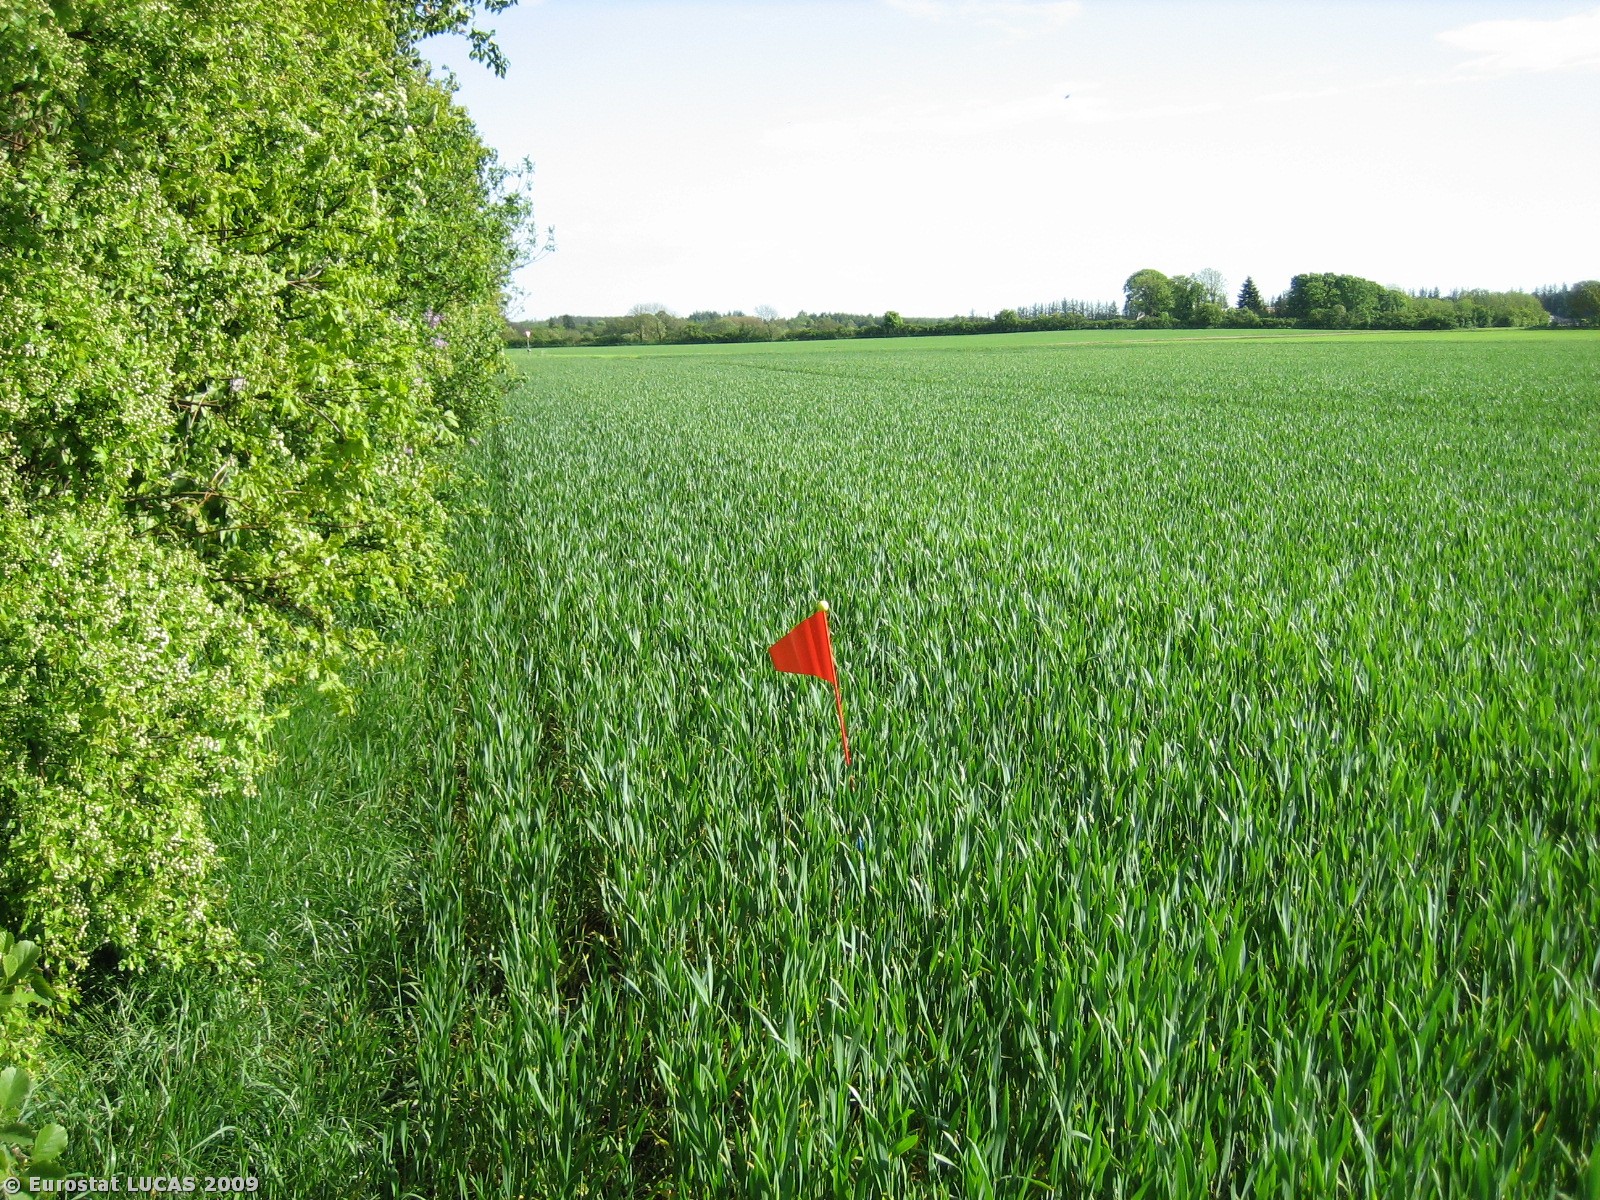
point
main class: Woodland
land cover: Broadleaved woodland
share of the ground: > 75 %
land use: Forestry
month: May
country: DK
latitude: 56.1638
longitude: 8.7615
